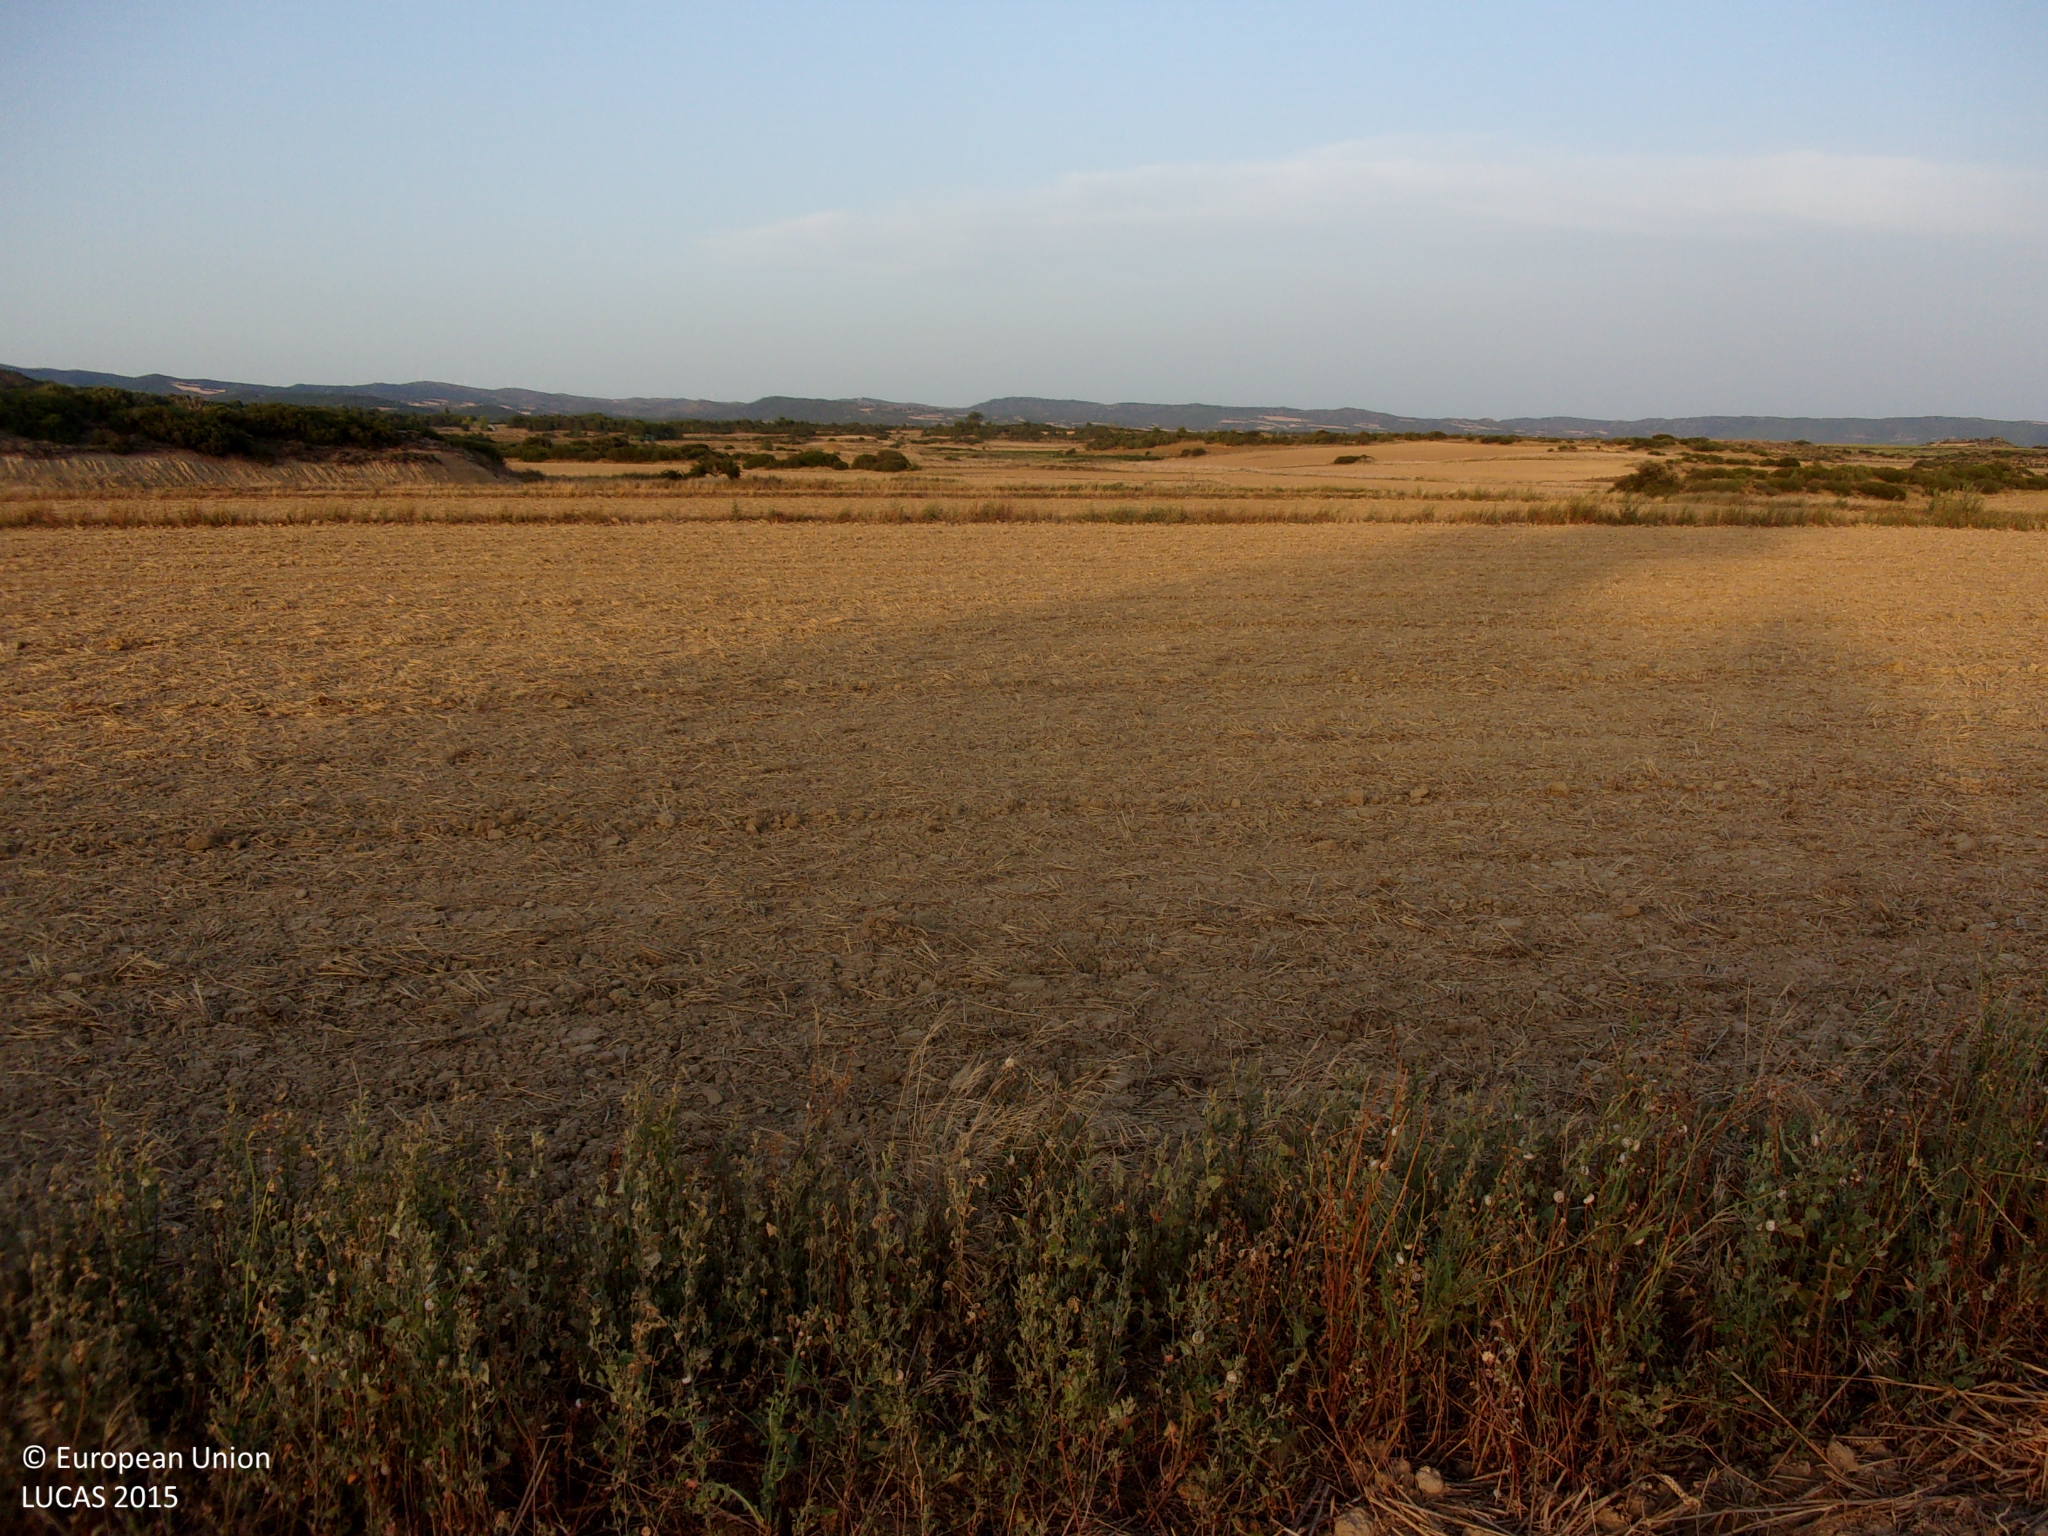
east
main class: Cropland
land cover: Common wheat
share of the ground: < 10 %
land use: Agriculture (excluding fallow land and kitchen gardens)
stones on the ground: < 10 %
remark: Harvested field
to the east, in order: Common wheat; Grass margins; Common wheat; Grass margins; Common wheat; Grass margins; Common wheat; Grass margins; Common wheat; Grass margins; Ditches and canals; Grass margins; Common wheat
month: August
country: ES
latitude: 42.4275
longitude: -1.3977
